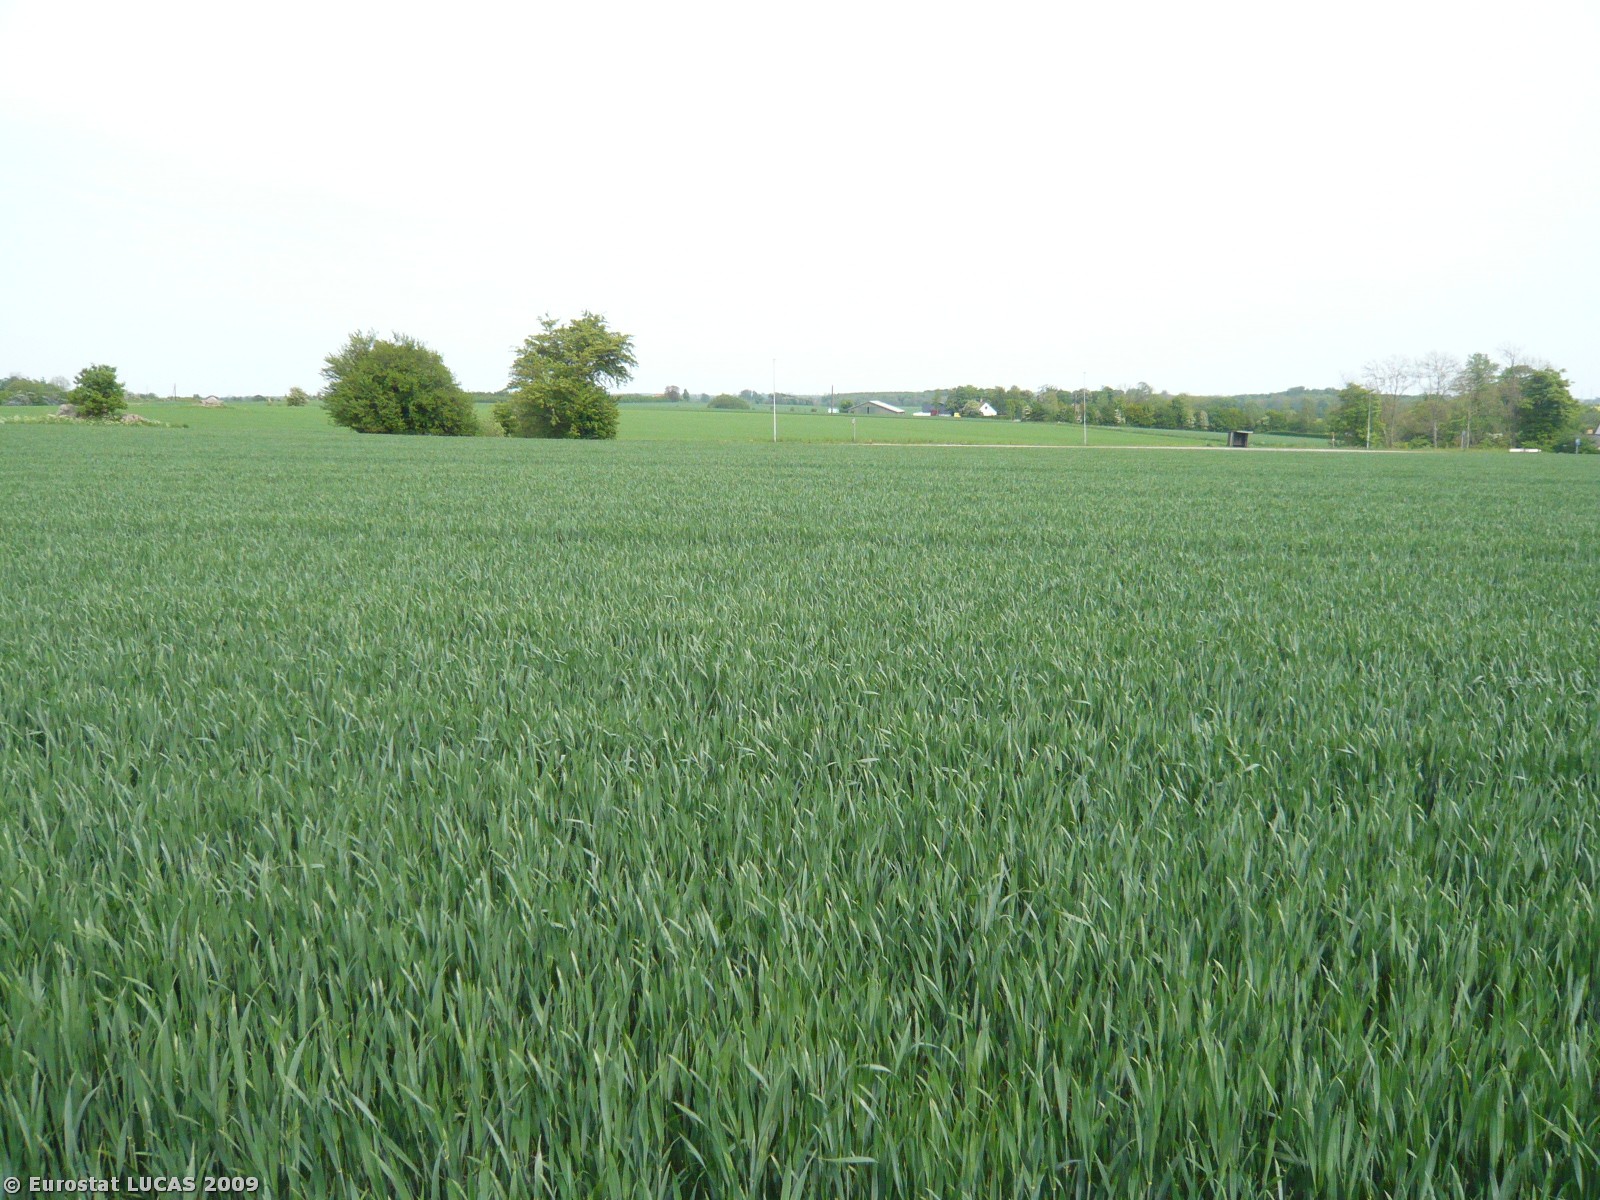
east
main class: Cropland
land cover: Common wheat
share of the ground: > 75 %
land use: Agriculture (excluding fallow land and kitchen gardens)
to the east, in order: Common wheat; Barley; Grass margins; Paved roads, cycling and walking lanes; Grassland without tree/shrub cover; Barley
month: May
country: DK
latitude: 55.3834
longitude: 11.8453
